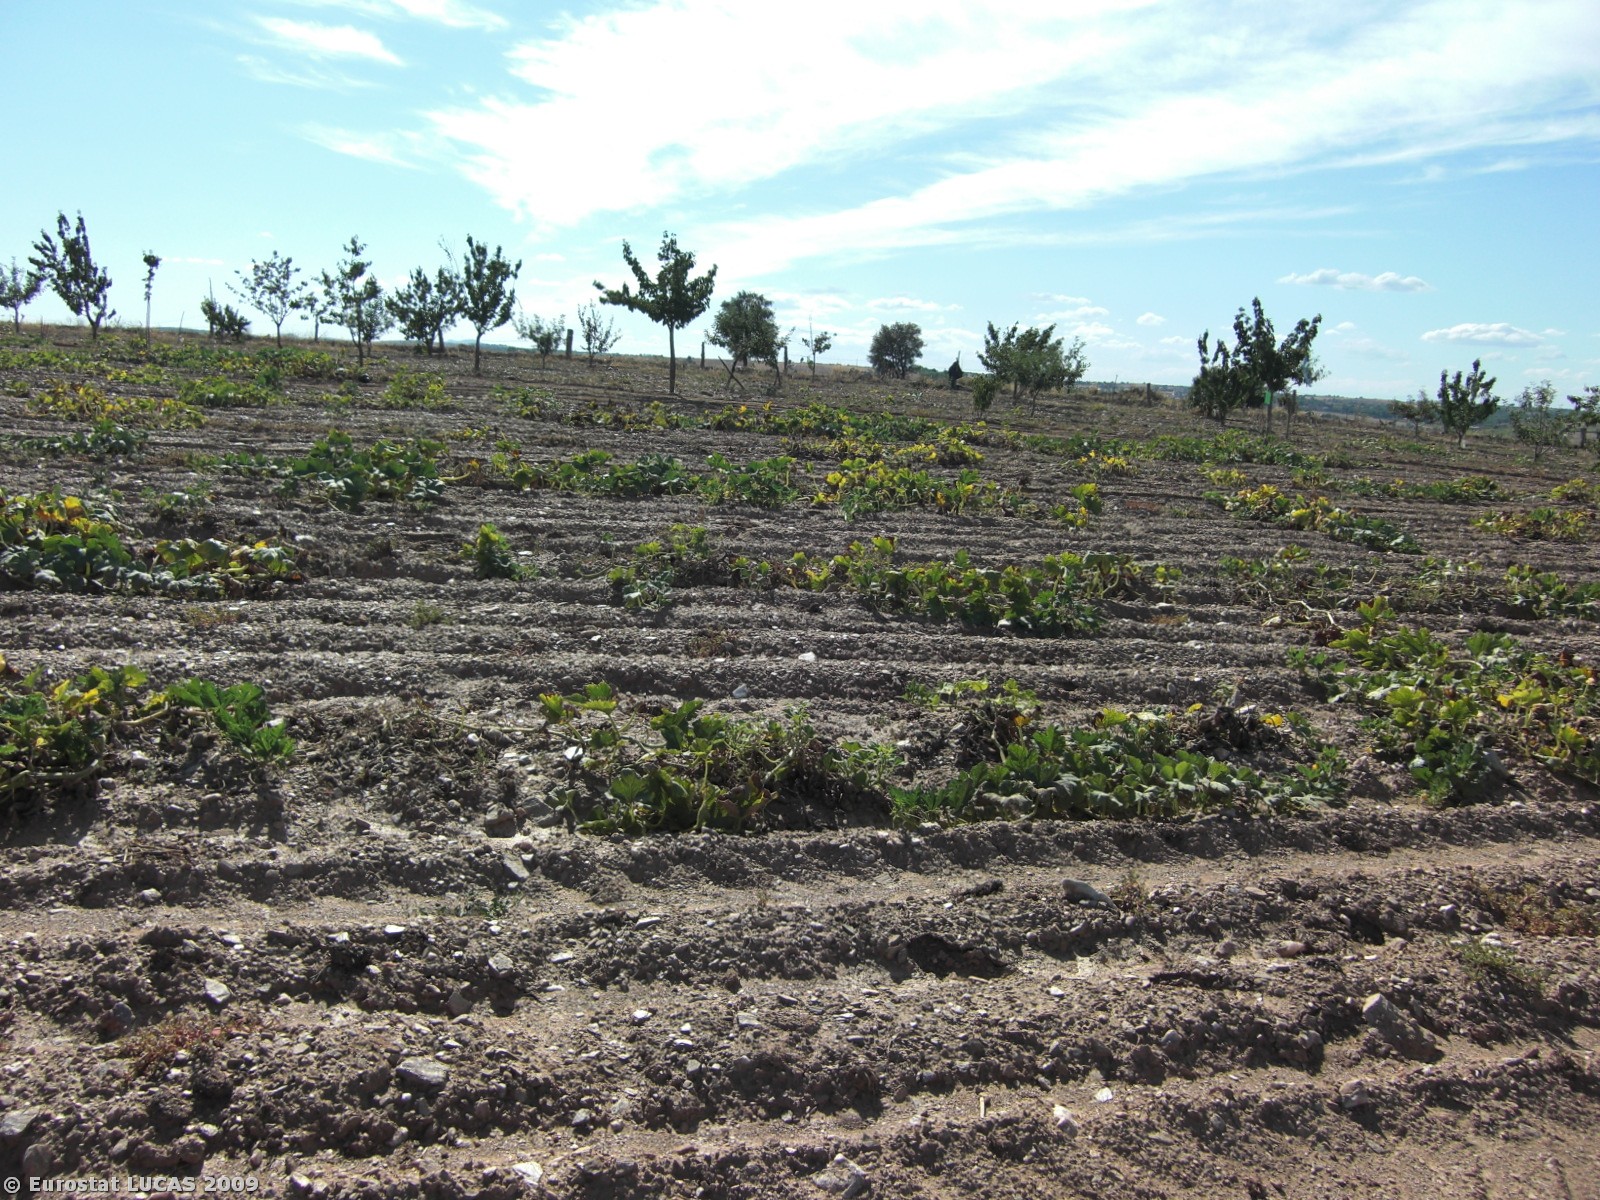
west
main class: Cropland
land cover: Other fresh vegetables
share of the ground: 10 - 25 %
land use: Agriculture (excluding fallow land and kitchen gardens)
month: August
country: PT
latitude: 41.4667
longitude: -6.3221
